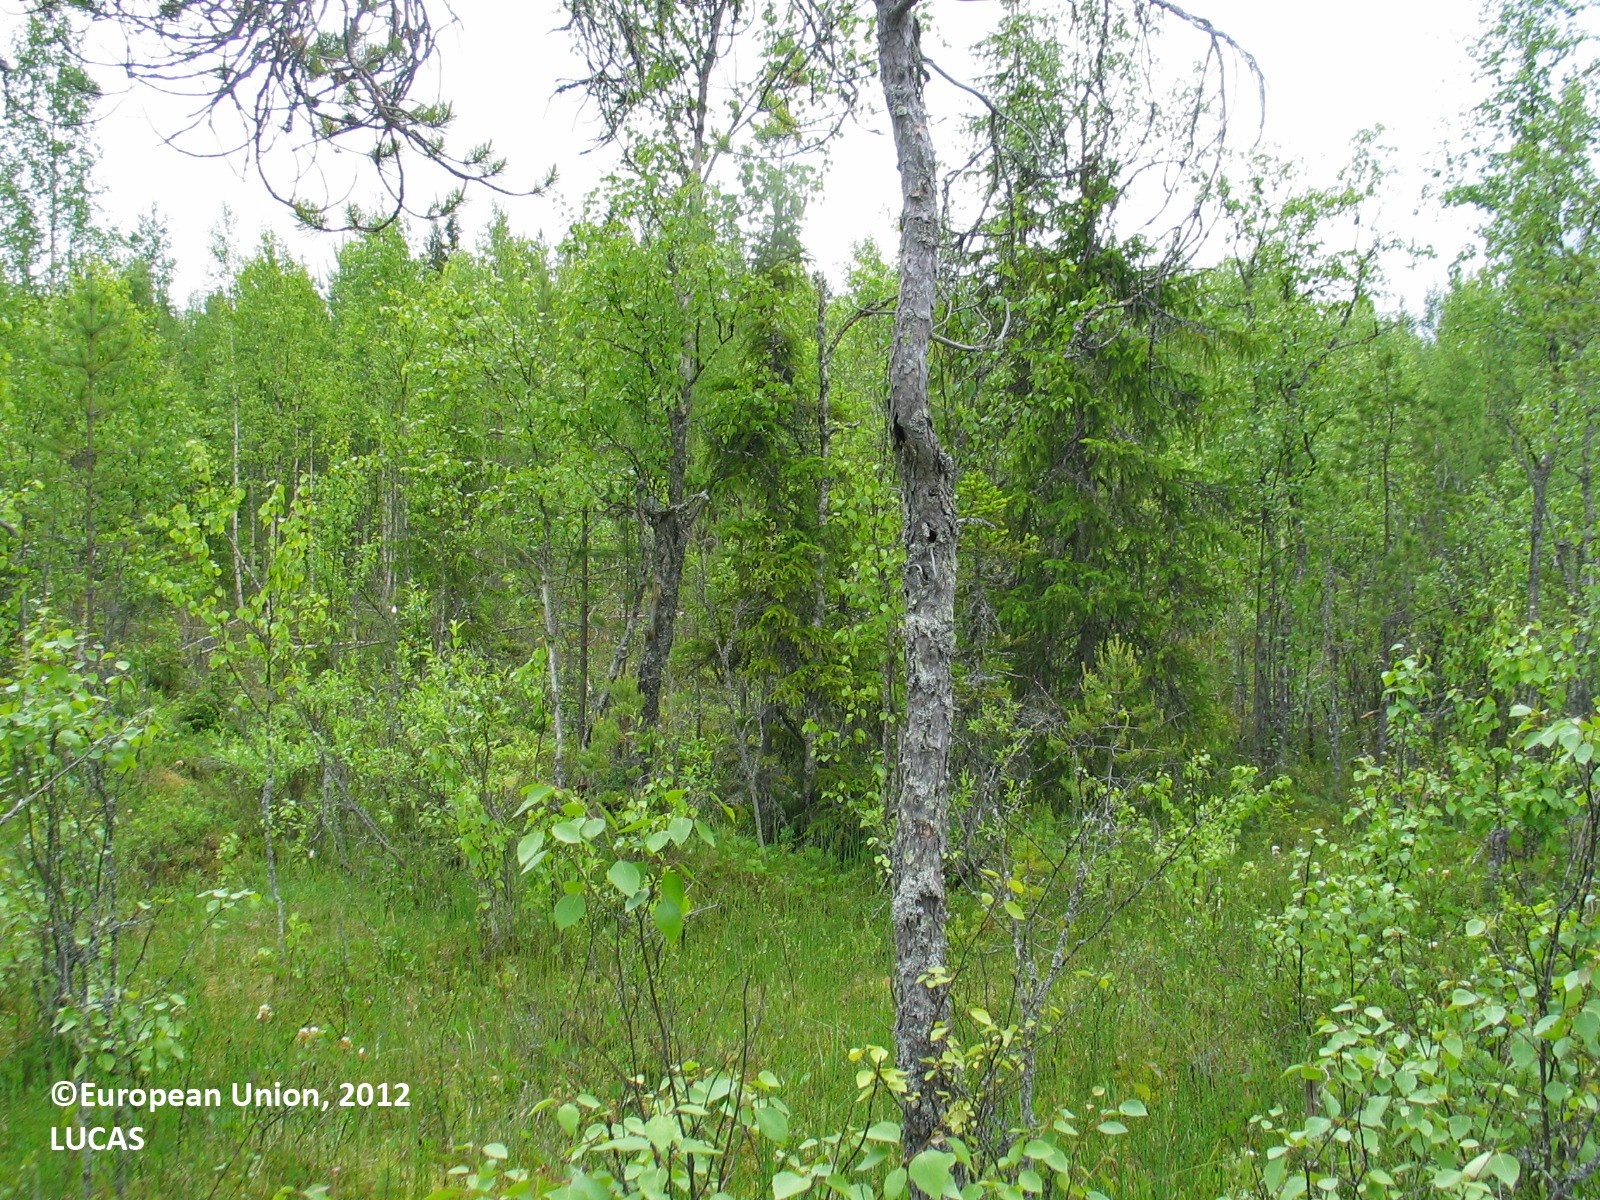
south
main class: Woodland
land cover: Pine dominated coniferous woodland
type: mire and swamp forests
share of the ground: 10 - 25 %
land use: Semi-natural and natural areas not in use
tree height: > 5 m
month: June
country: FI
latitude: 64.8653
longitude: 26.6351
